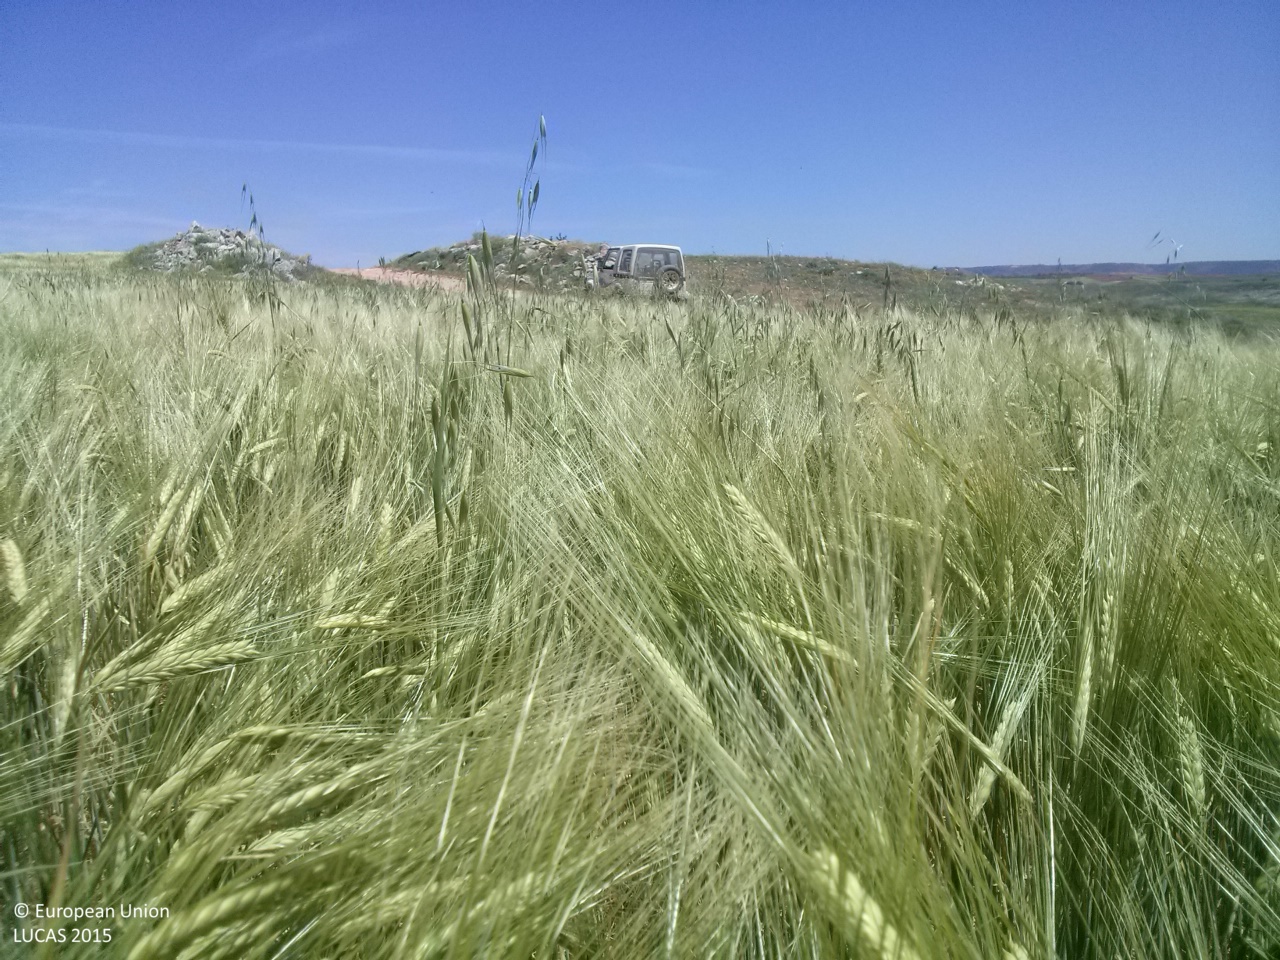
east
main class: Cropland
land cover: Barley
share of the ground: > 75 %
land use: Agriculture (excluding fallow land and kitchen gardens)
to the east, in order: Barley; Grass margins; Tracks; Grassland with sparse tree/shrub cover; Barley
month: May
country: ES
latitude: 40.0075
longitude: -2.6837
